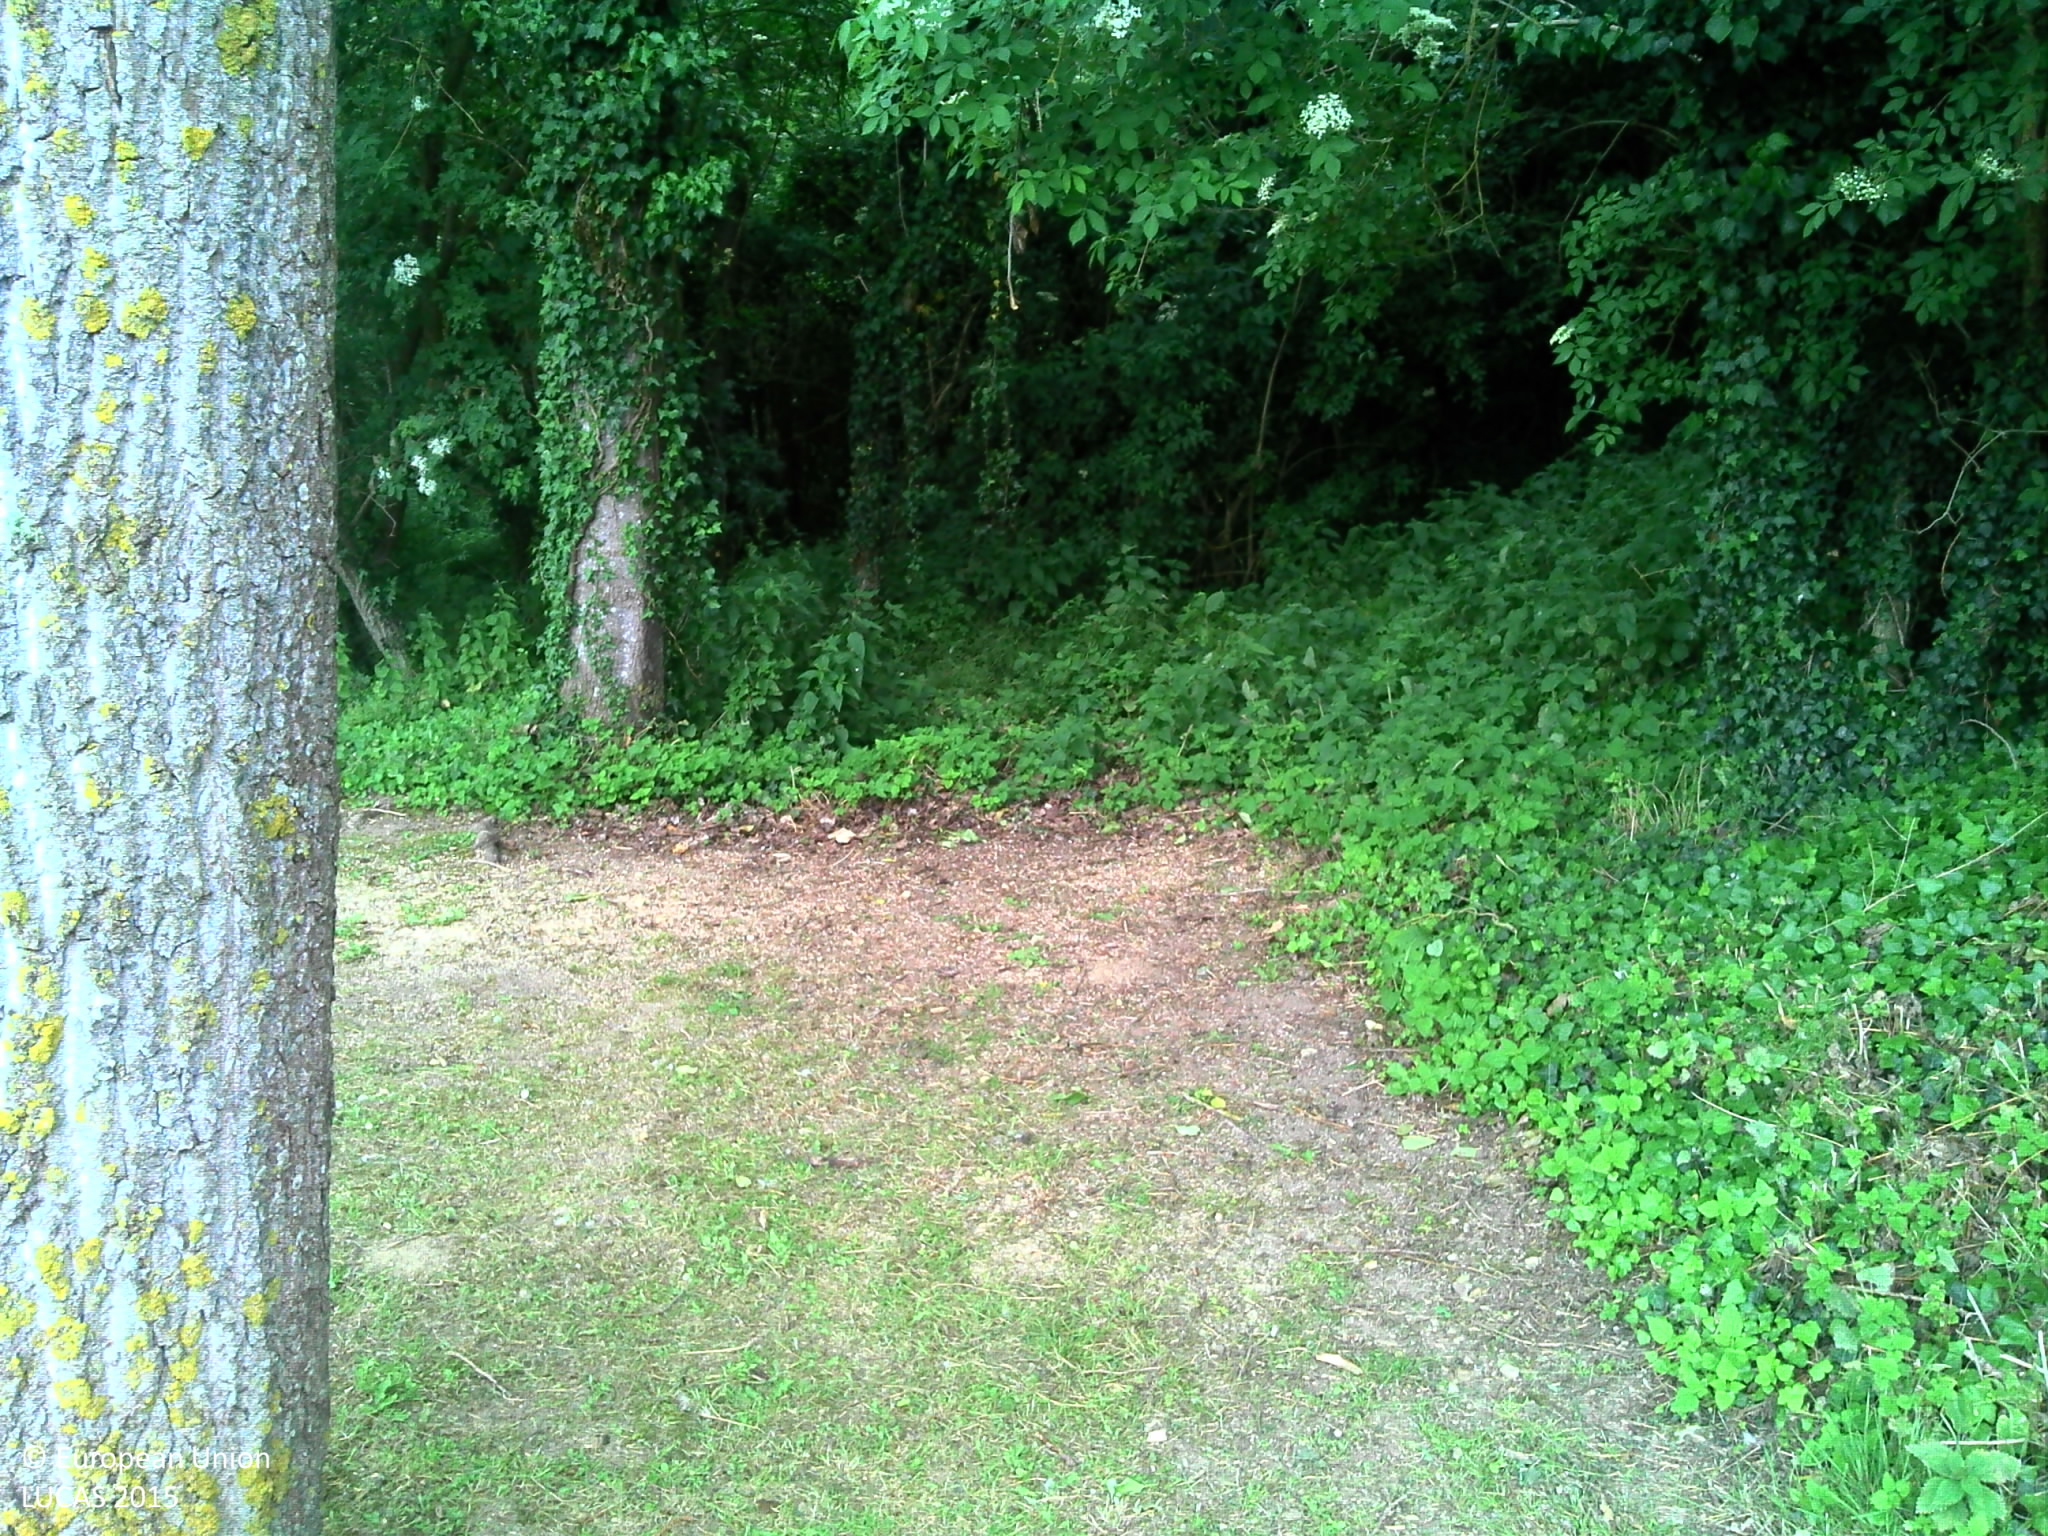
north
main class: Cropland
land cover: Other non-permanent industrial crops
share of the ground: > 75 %
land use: Kitchen garden
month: June
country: FR
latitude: 49.4817
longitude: 3.2976
